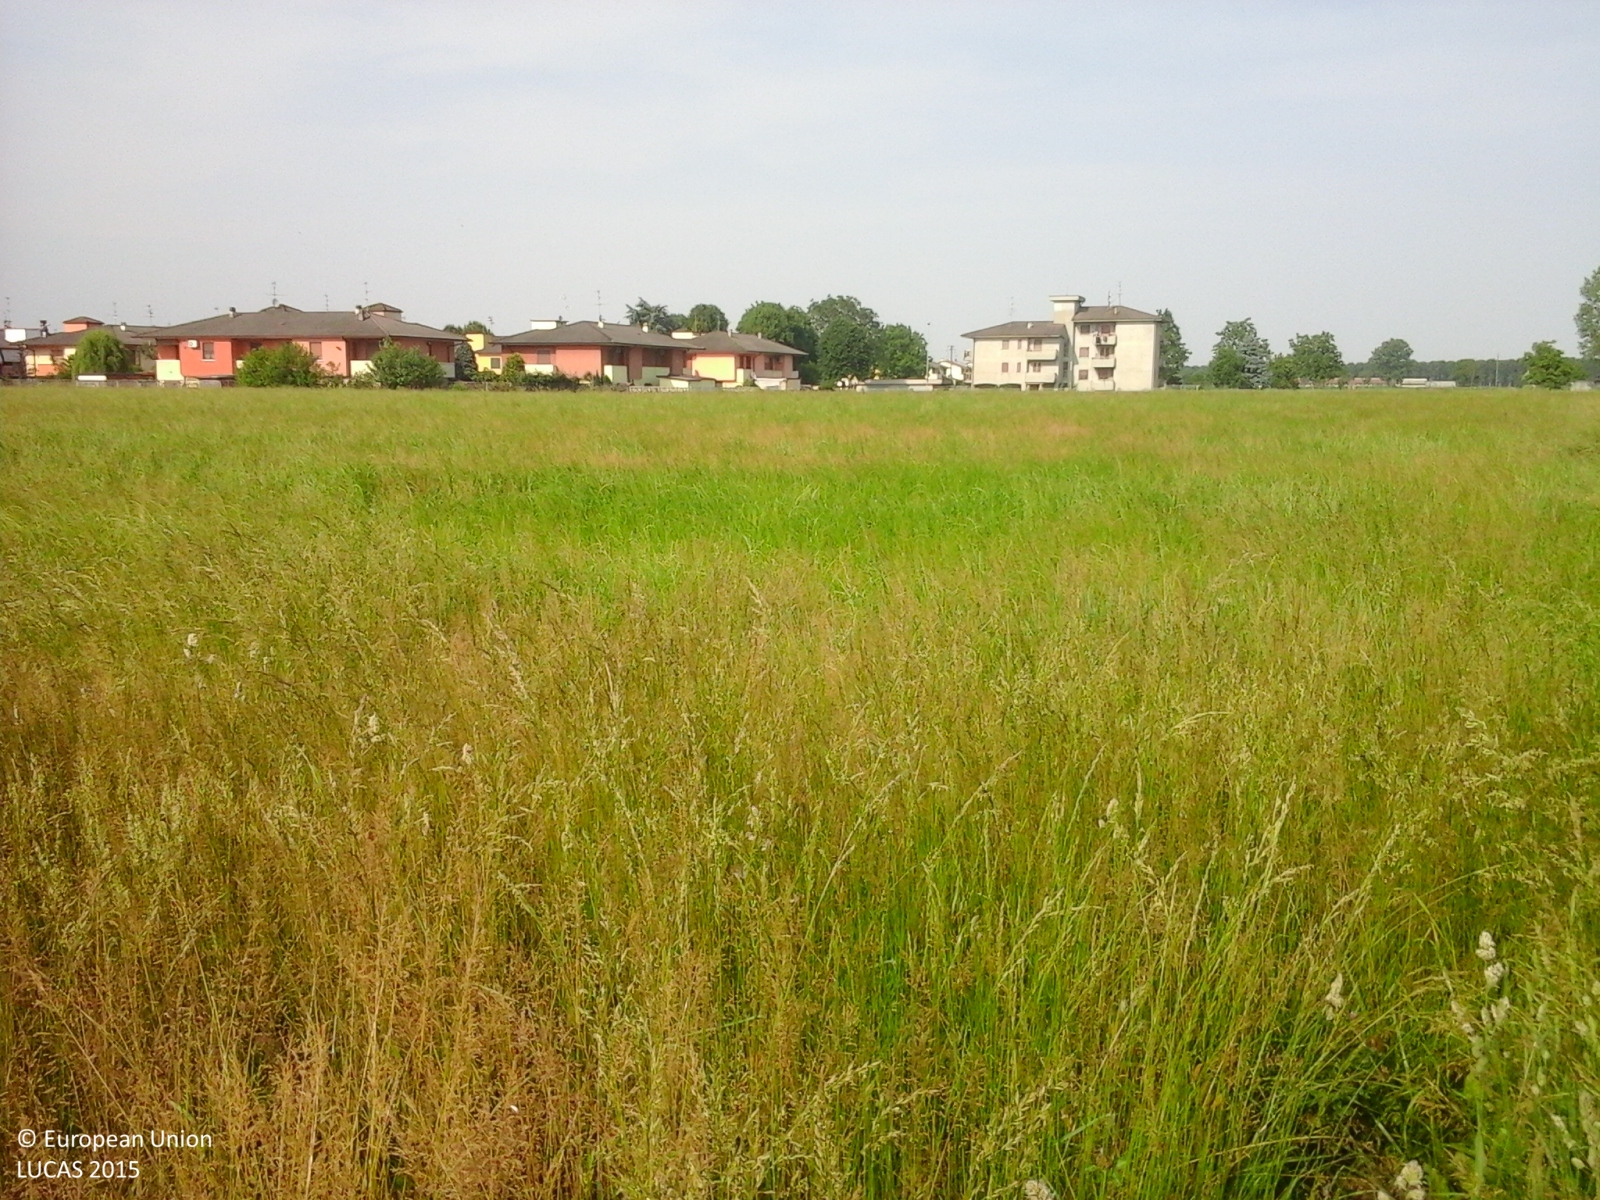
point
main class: Cropland
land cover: Temporary grasslands
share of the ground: > 75 %
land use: Agriculture (excluding fallow land and kitchen gardens)
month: May
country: IT
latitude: 45.2502
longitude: 9.3768
